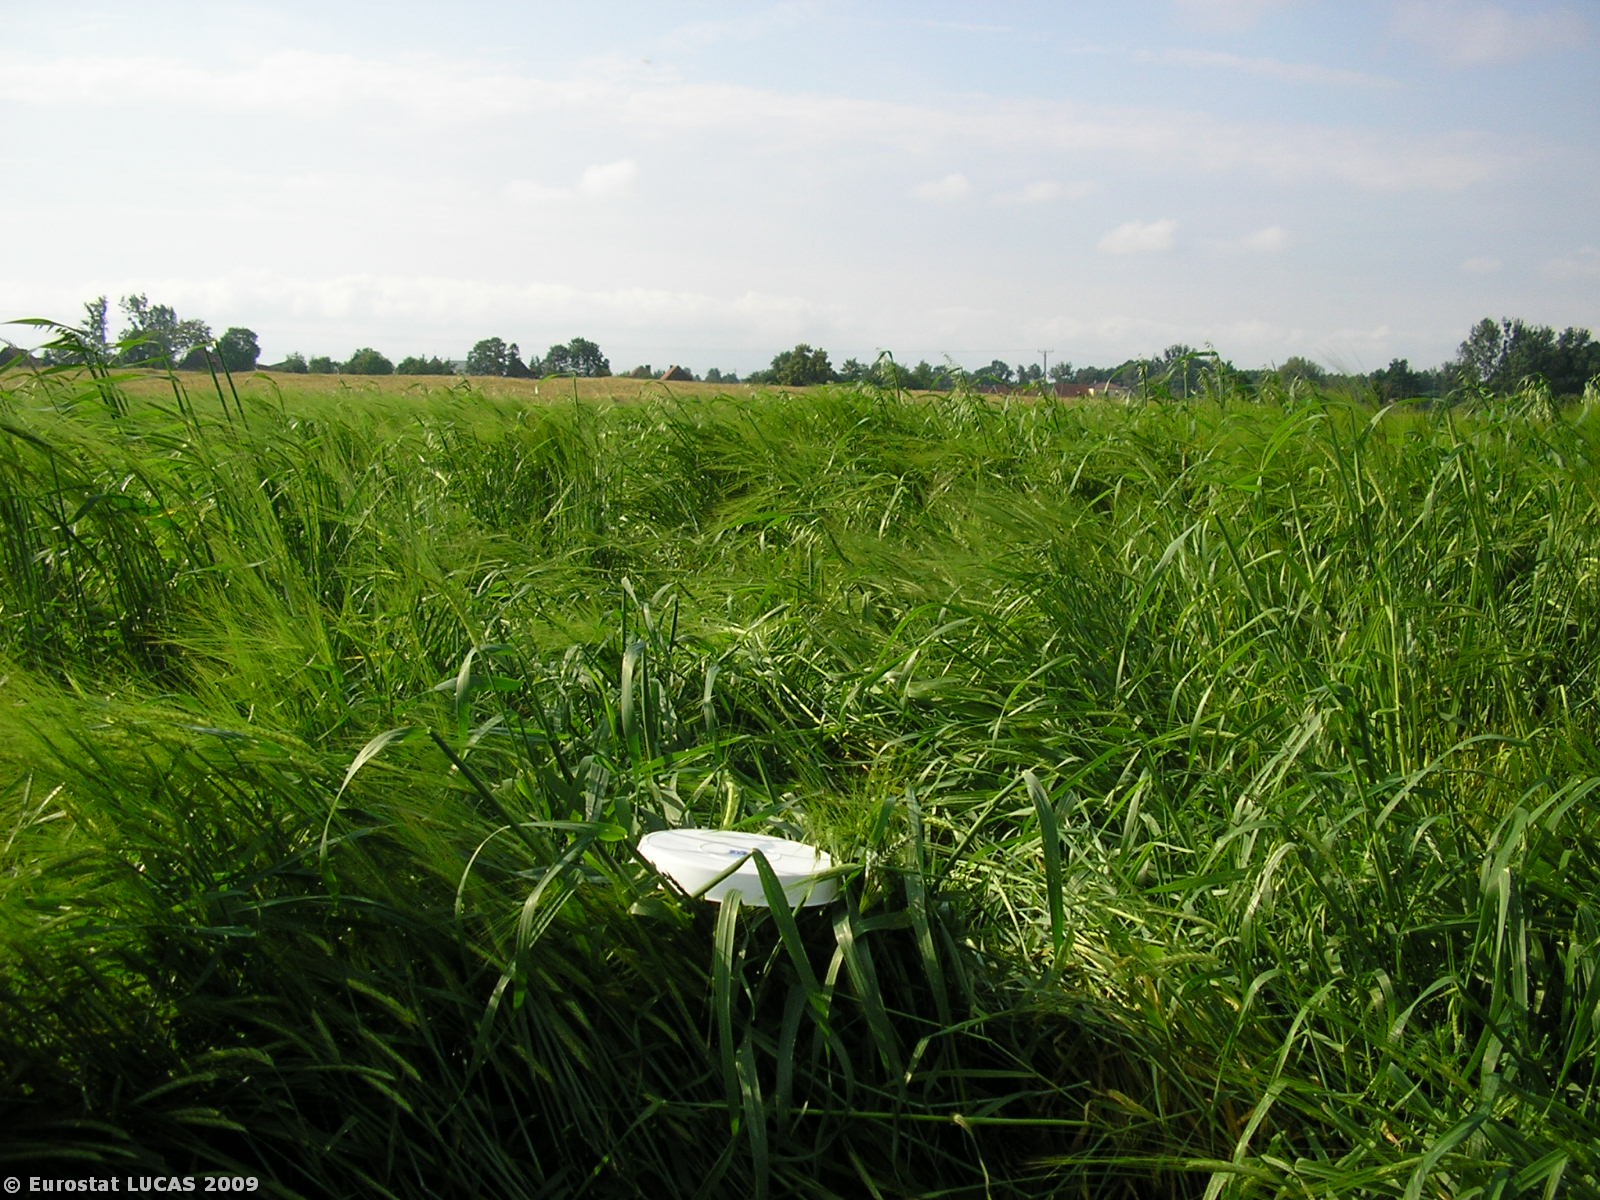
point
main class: Cropland
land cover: Barley
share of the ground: > 75 %
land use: Agriculture (excluding fallow land and kitchen gardens)
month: June
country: PL
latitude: 51.0853
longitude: 18.3986
